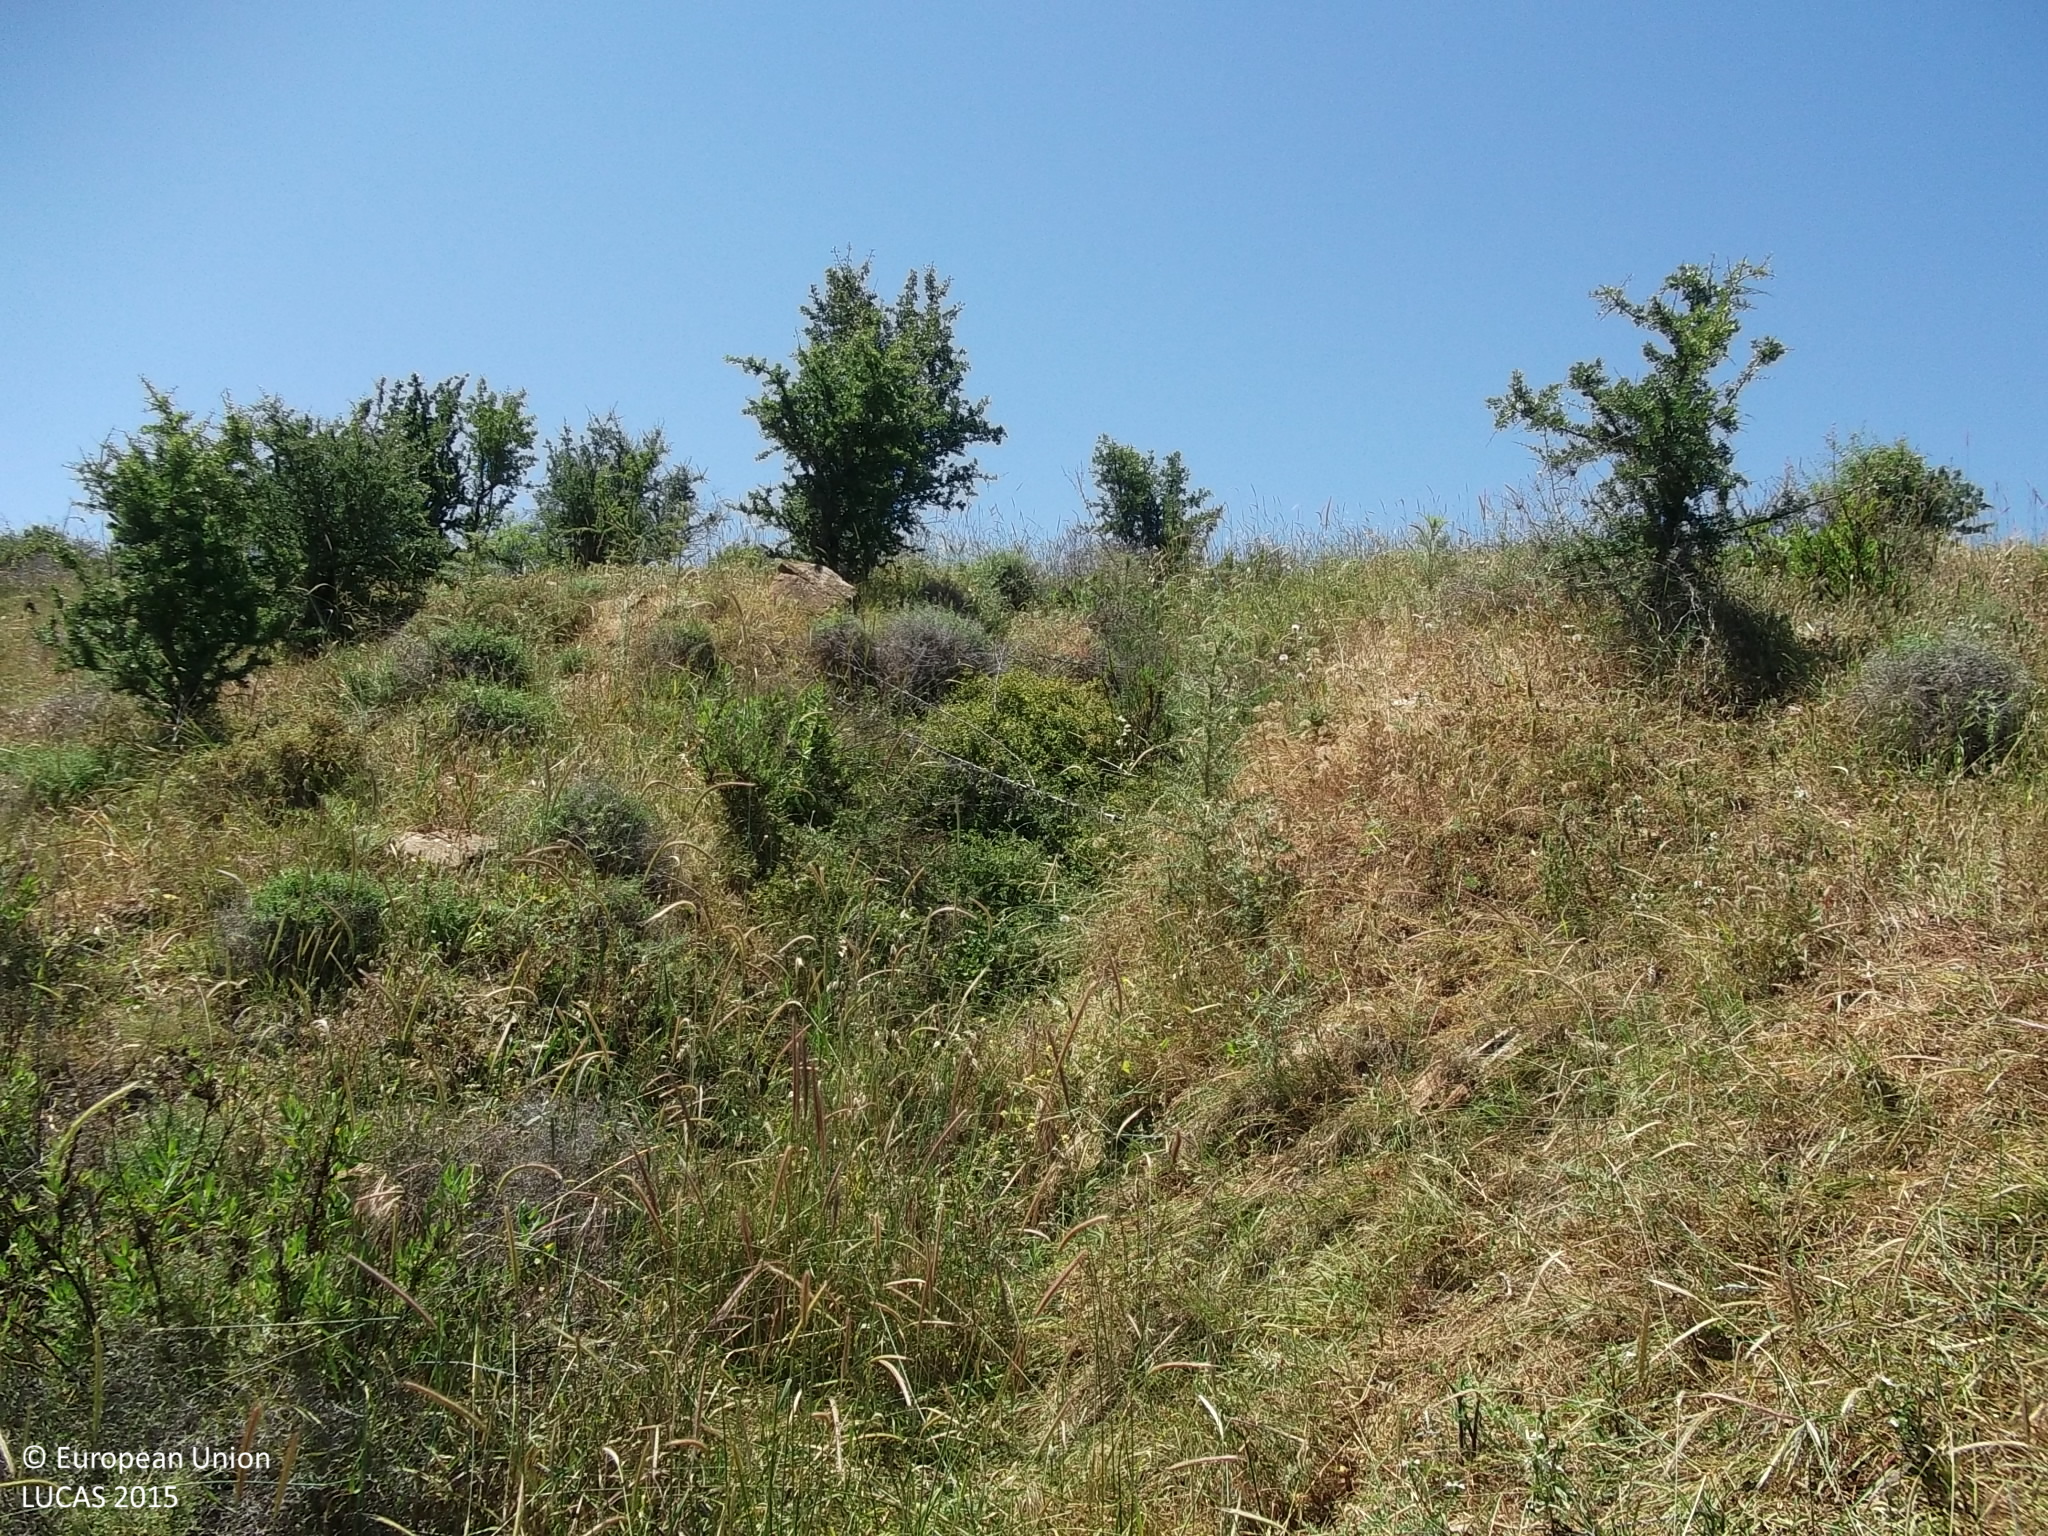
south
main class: Grassland
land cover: Grassland without tree/shrub cover
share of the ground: > 75 %
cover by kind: herbaceous plants 95 %, shrubs 5 %
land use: Semi-natural and natural areas not in use
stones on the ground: 25 - 50 %
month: May
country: CY
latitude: 34.7793
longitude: 32.5395
